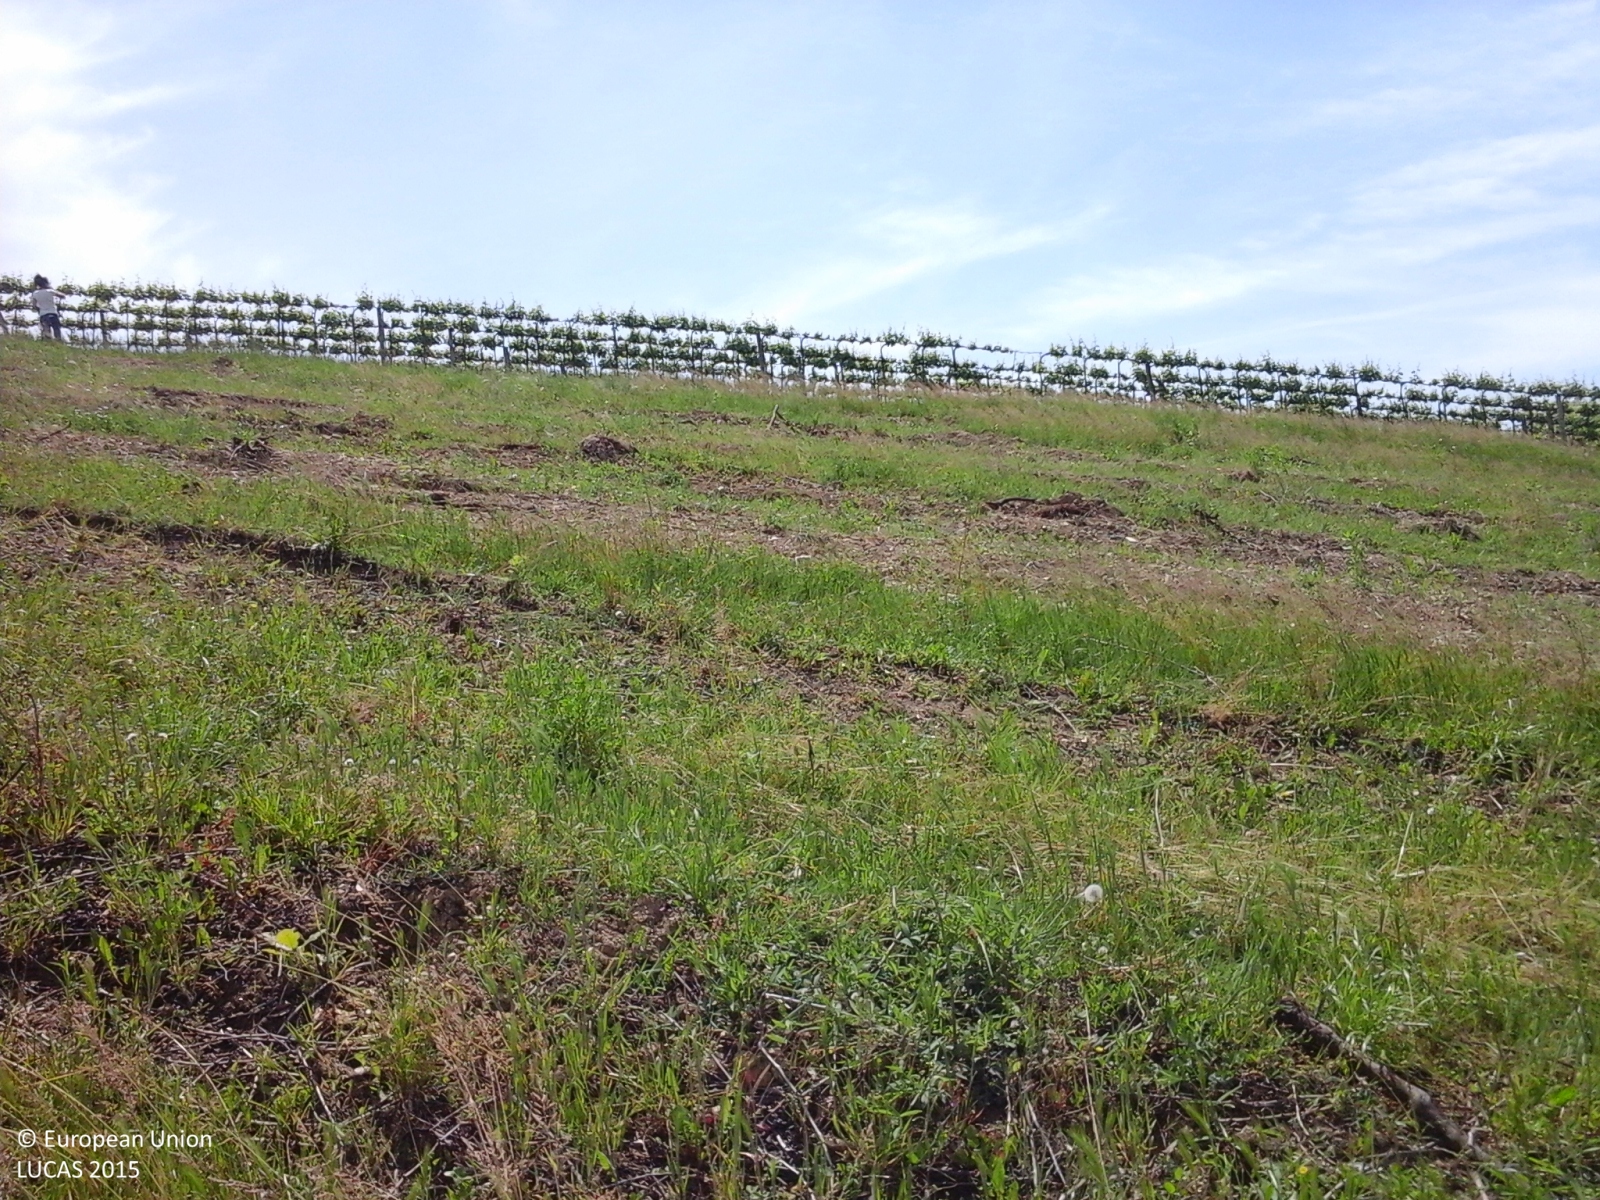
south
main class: Grassland
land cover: Spontaneously vegetated surfaces
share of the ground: > 75 %
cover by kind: herbaceous plants 100 %
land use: Agriculture (excluding fallow land and kitchen gardens)
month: May
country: IT
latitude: 45.0154
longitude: 9.3034
